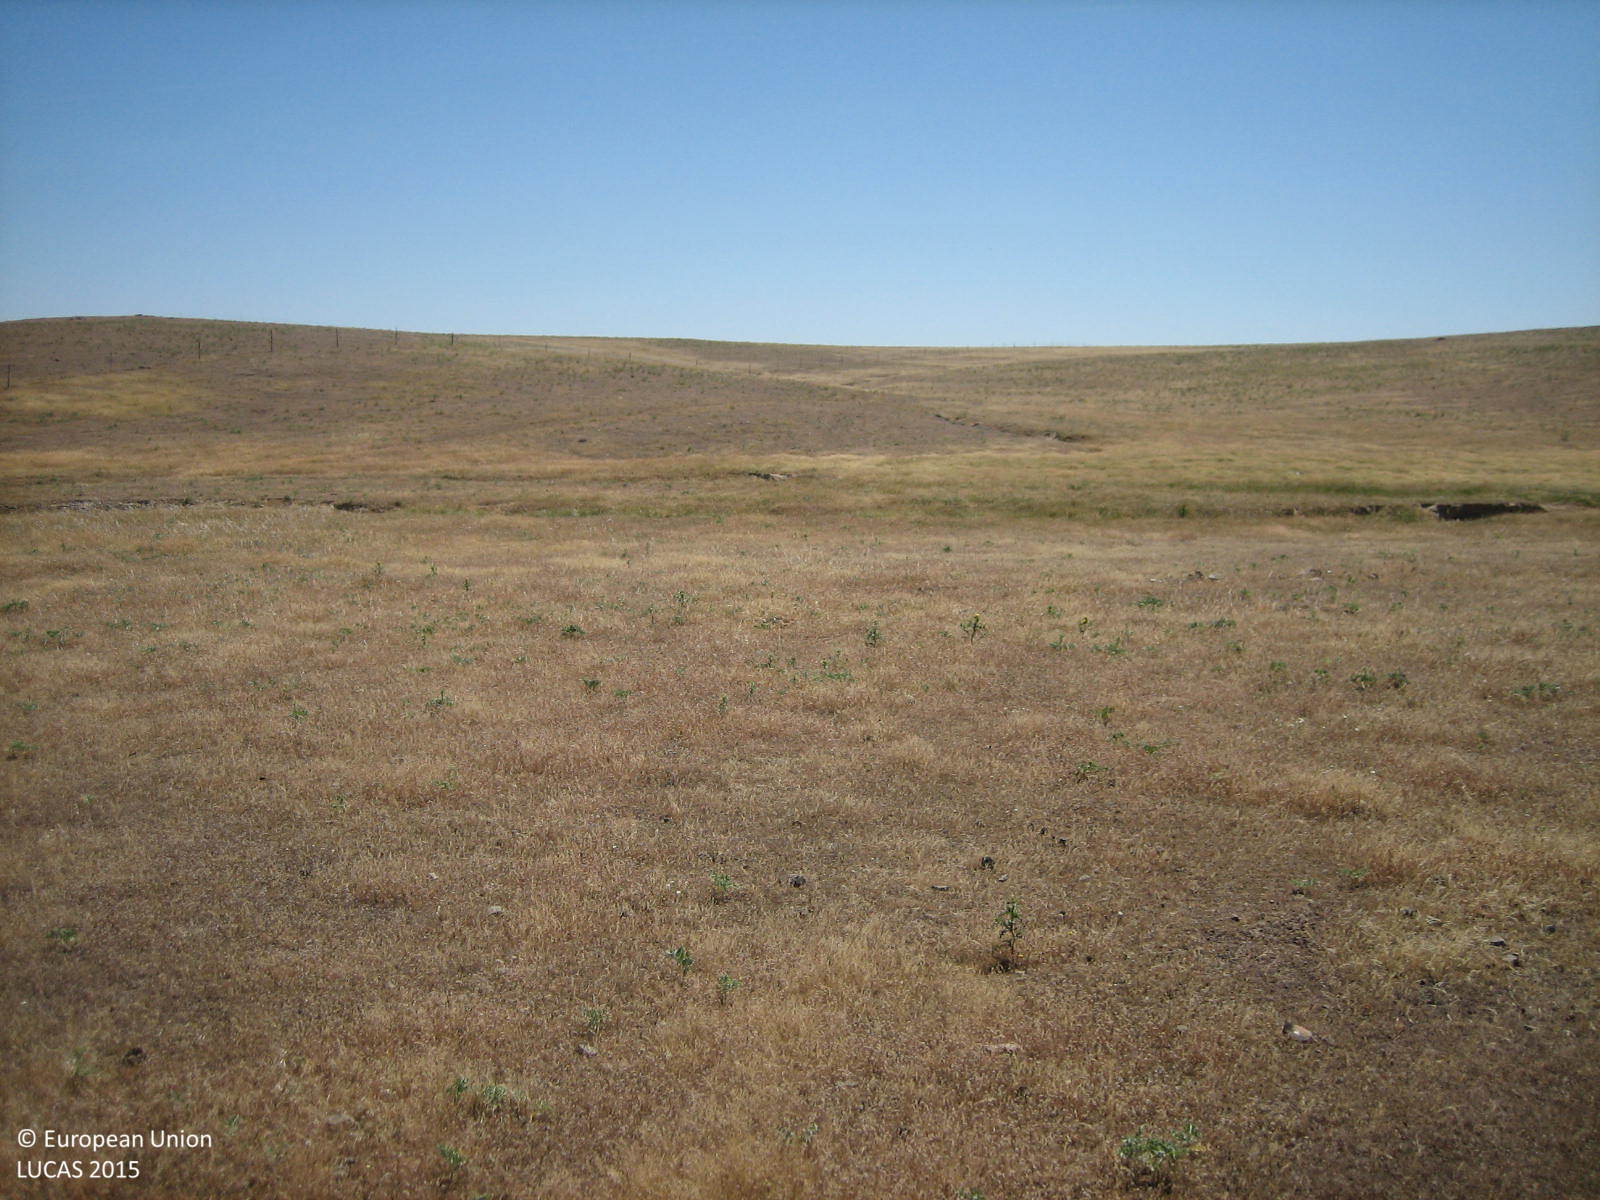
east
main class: Grassland
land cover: Spontaneously vegetated surfaces
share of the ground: > 75 %
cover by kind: herbaceous plants 100 %
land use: Agriculture (excluding fallow land and kitchen gardens)
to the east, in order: Spontaneously vegetated surfaces; Rivers and streams; Spontaneously vegetated surfaces; Fences; Spontaneously vegetated surfaces
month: May
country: ES
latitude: 38.9948
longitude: -4.8935
